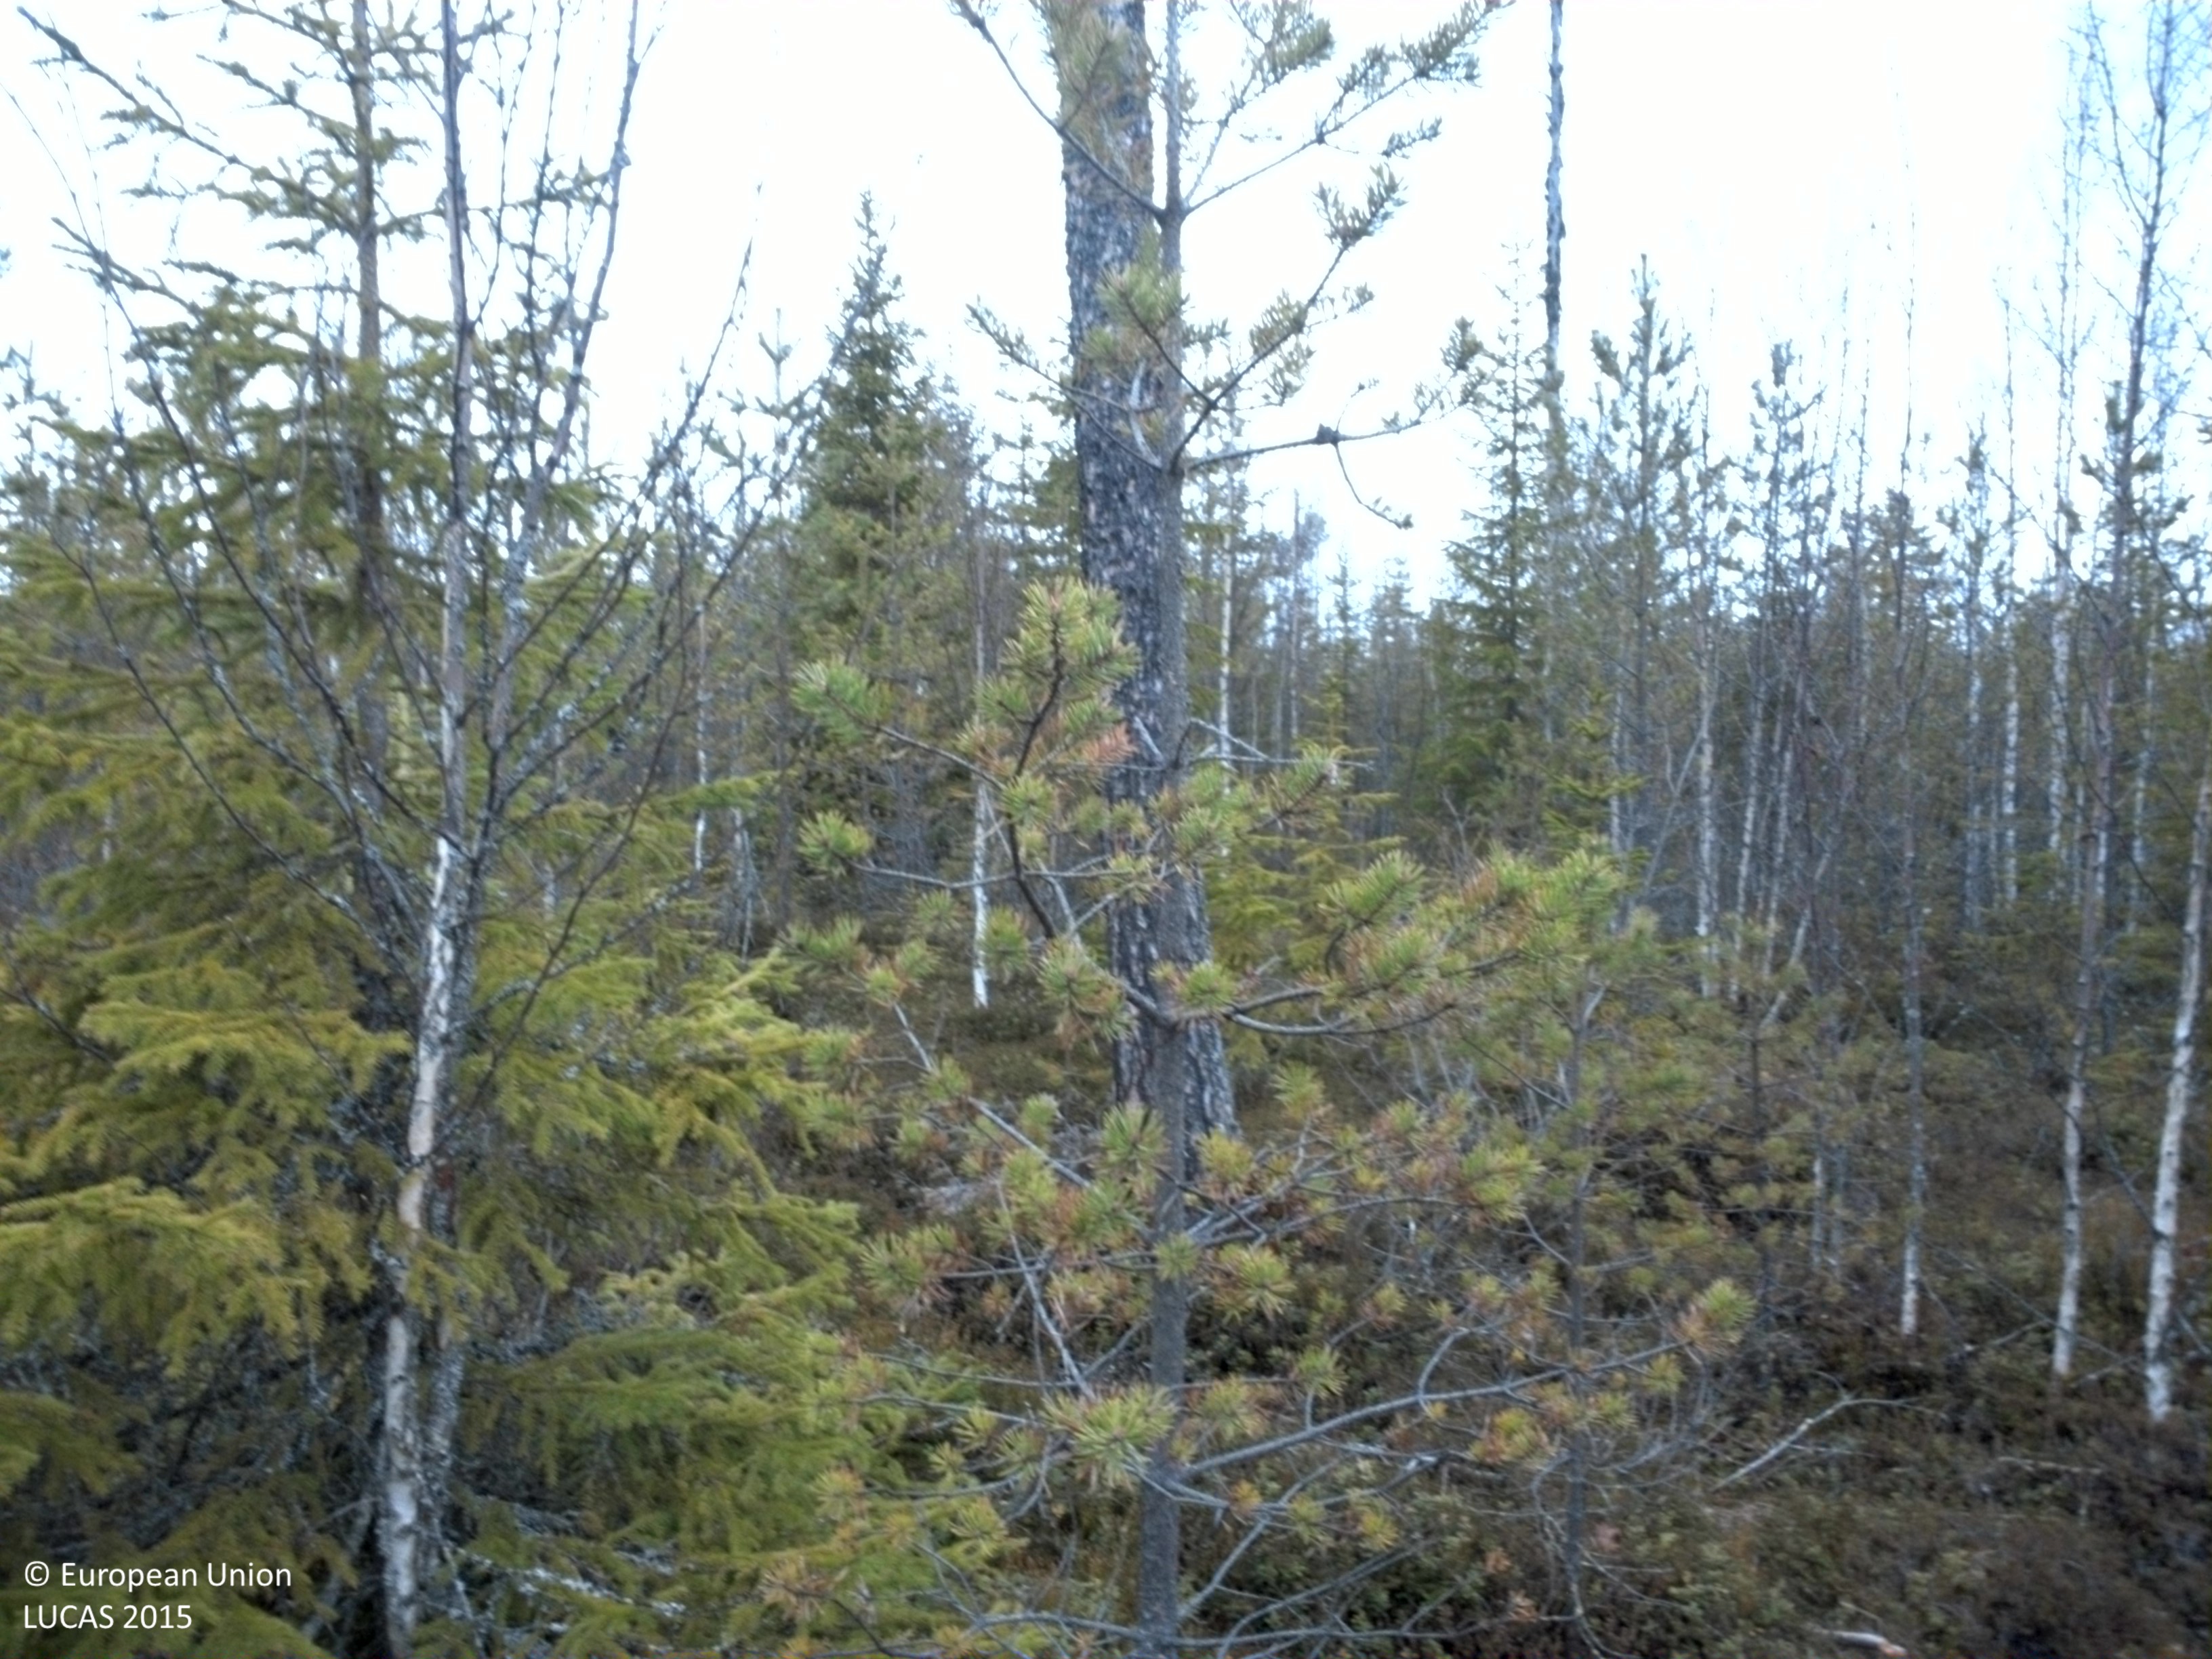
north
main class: Woodland
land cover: Pine dominated coniferous woodland
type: boreal forest
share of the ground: > 75 %
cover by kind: coniferous forest trees 85 %, shrubs 10 %, broadleaved forest trees 5 %
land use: Forestry
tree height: > 5 m
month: May
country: SE
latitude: 62.5830
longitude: 14.4393
